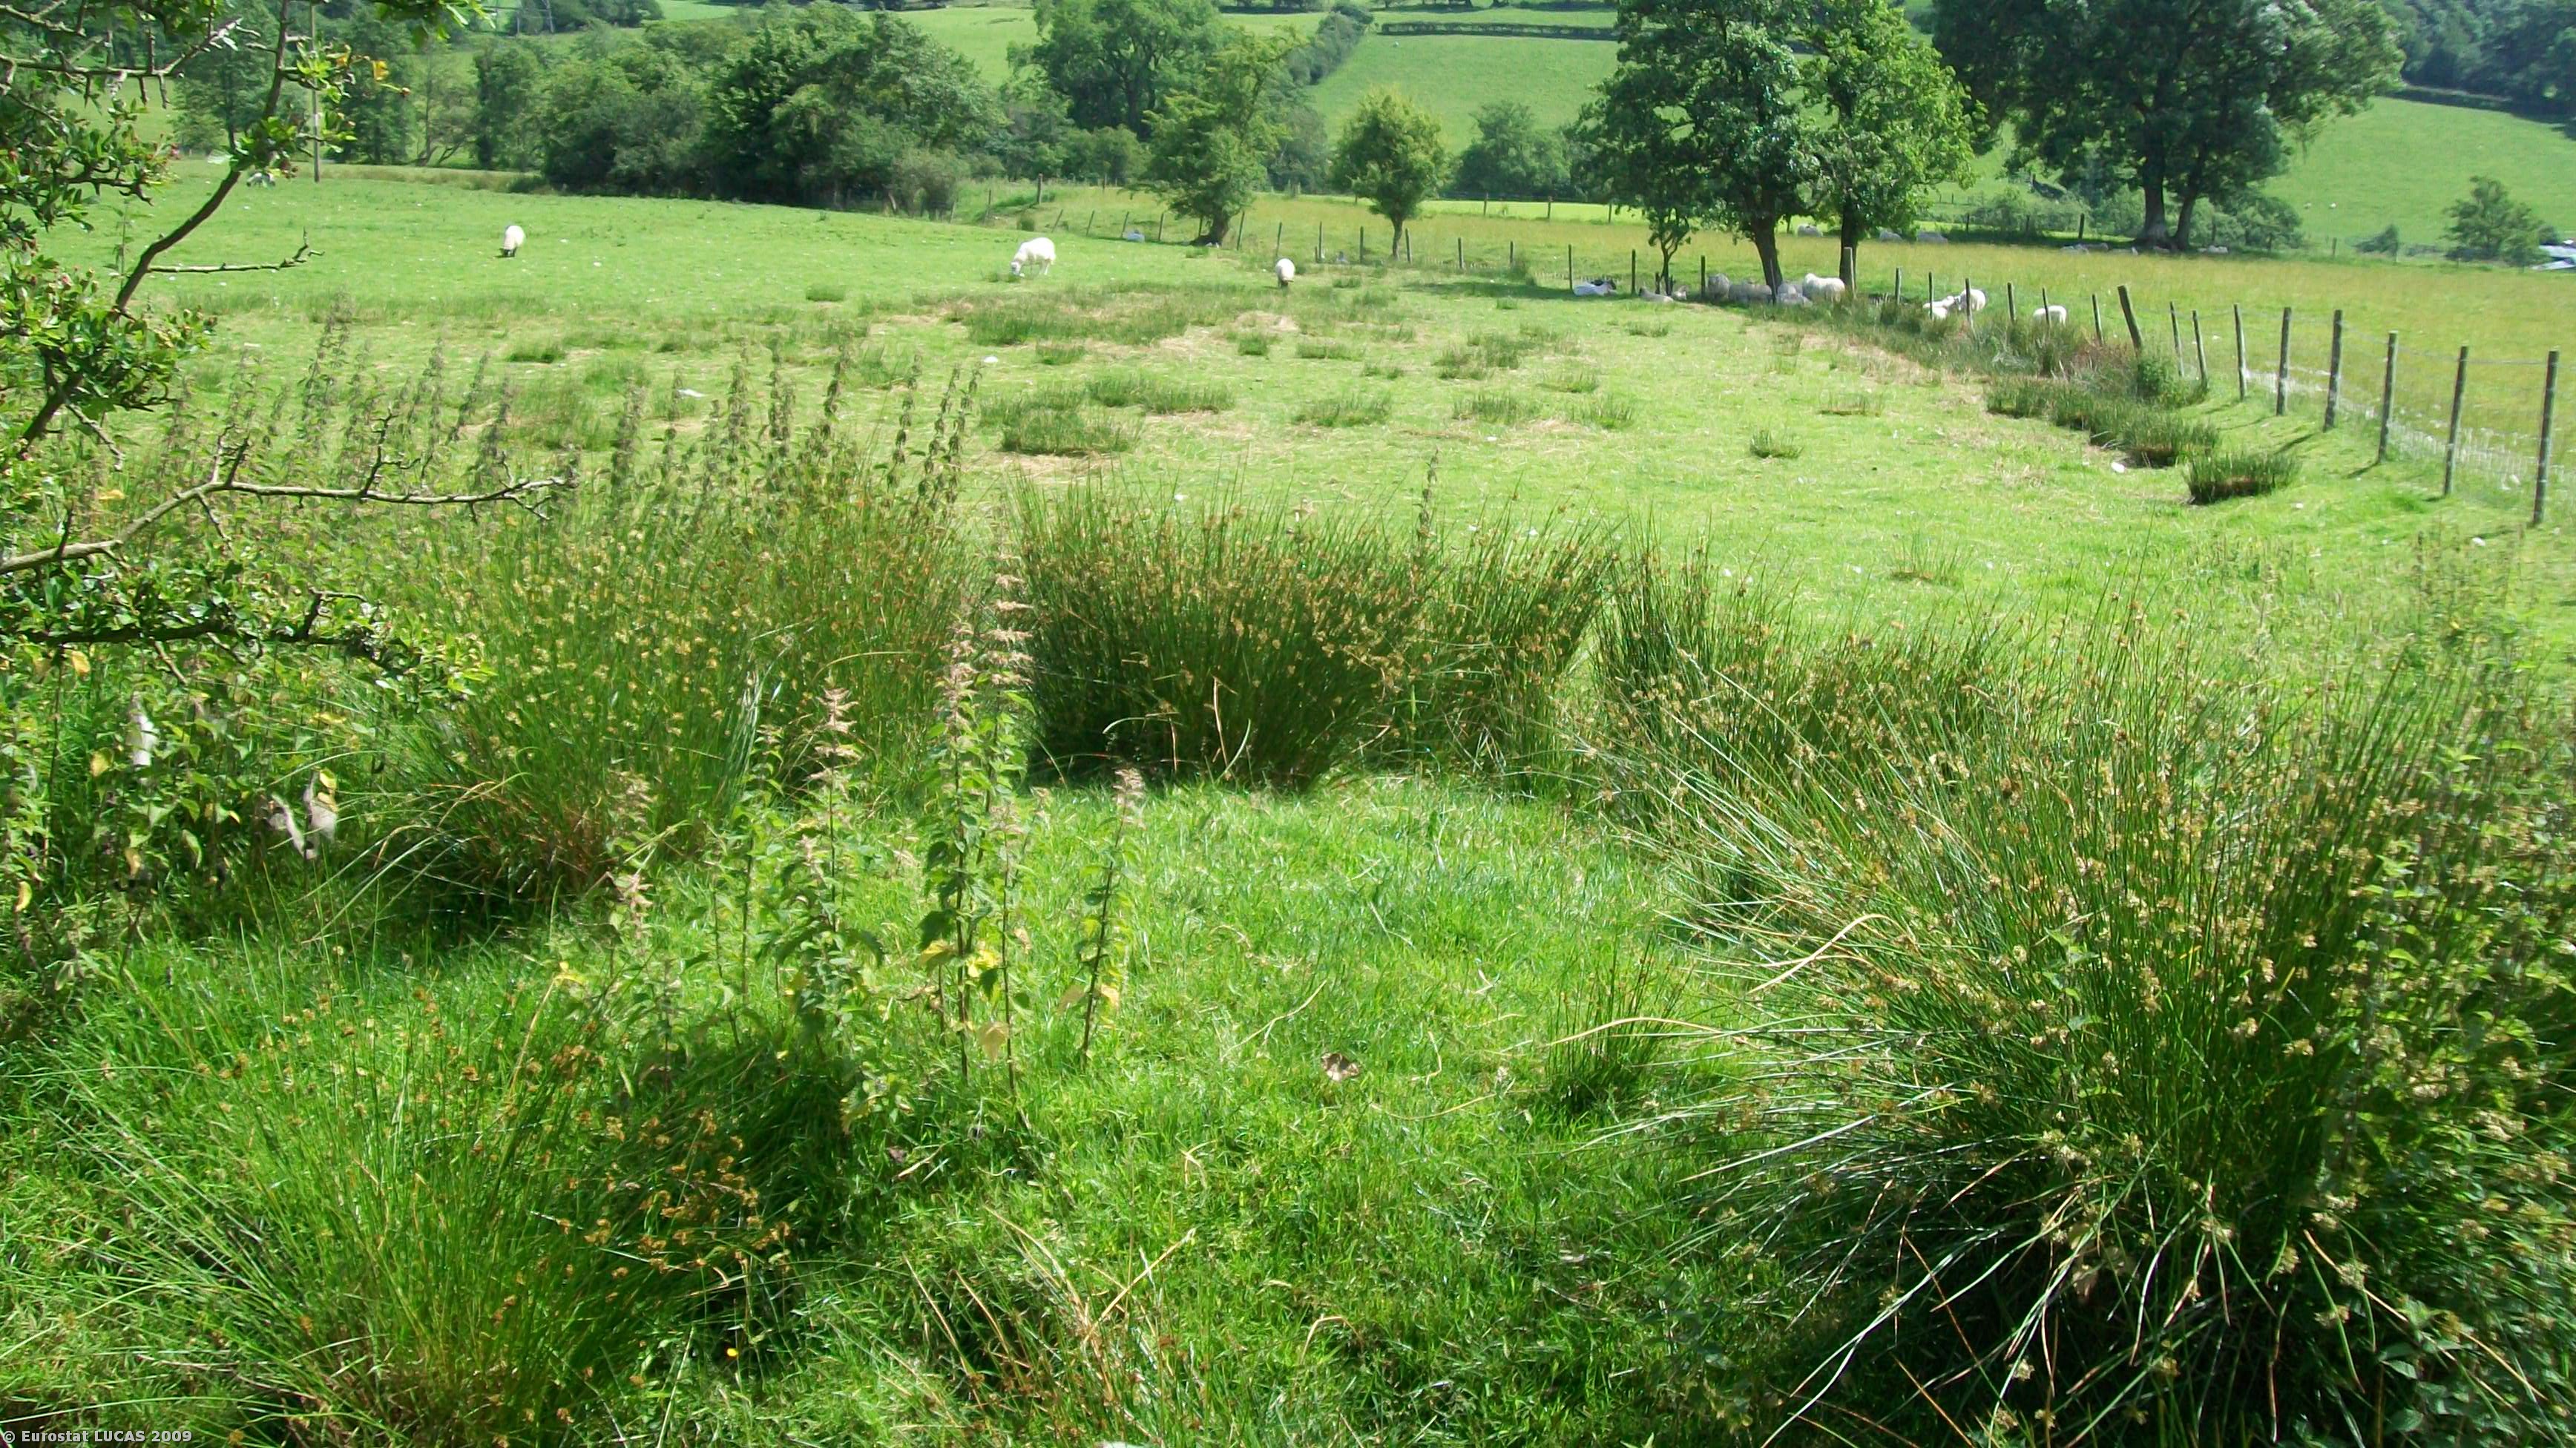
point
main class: Grassland
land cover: Grassland without tree/shrub cover
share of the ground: > 75 %
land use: Agriculture (excluding fallow land and kitchen gardens)
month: July
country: GB
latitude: 53.0104
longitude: -3.3002
